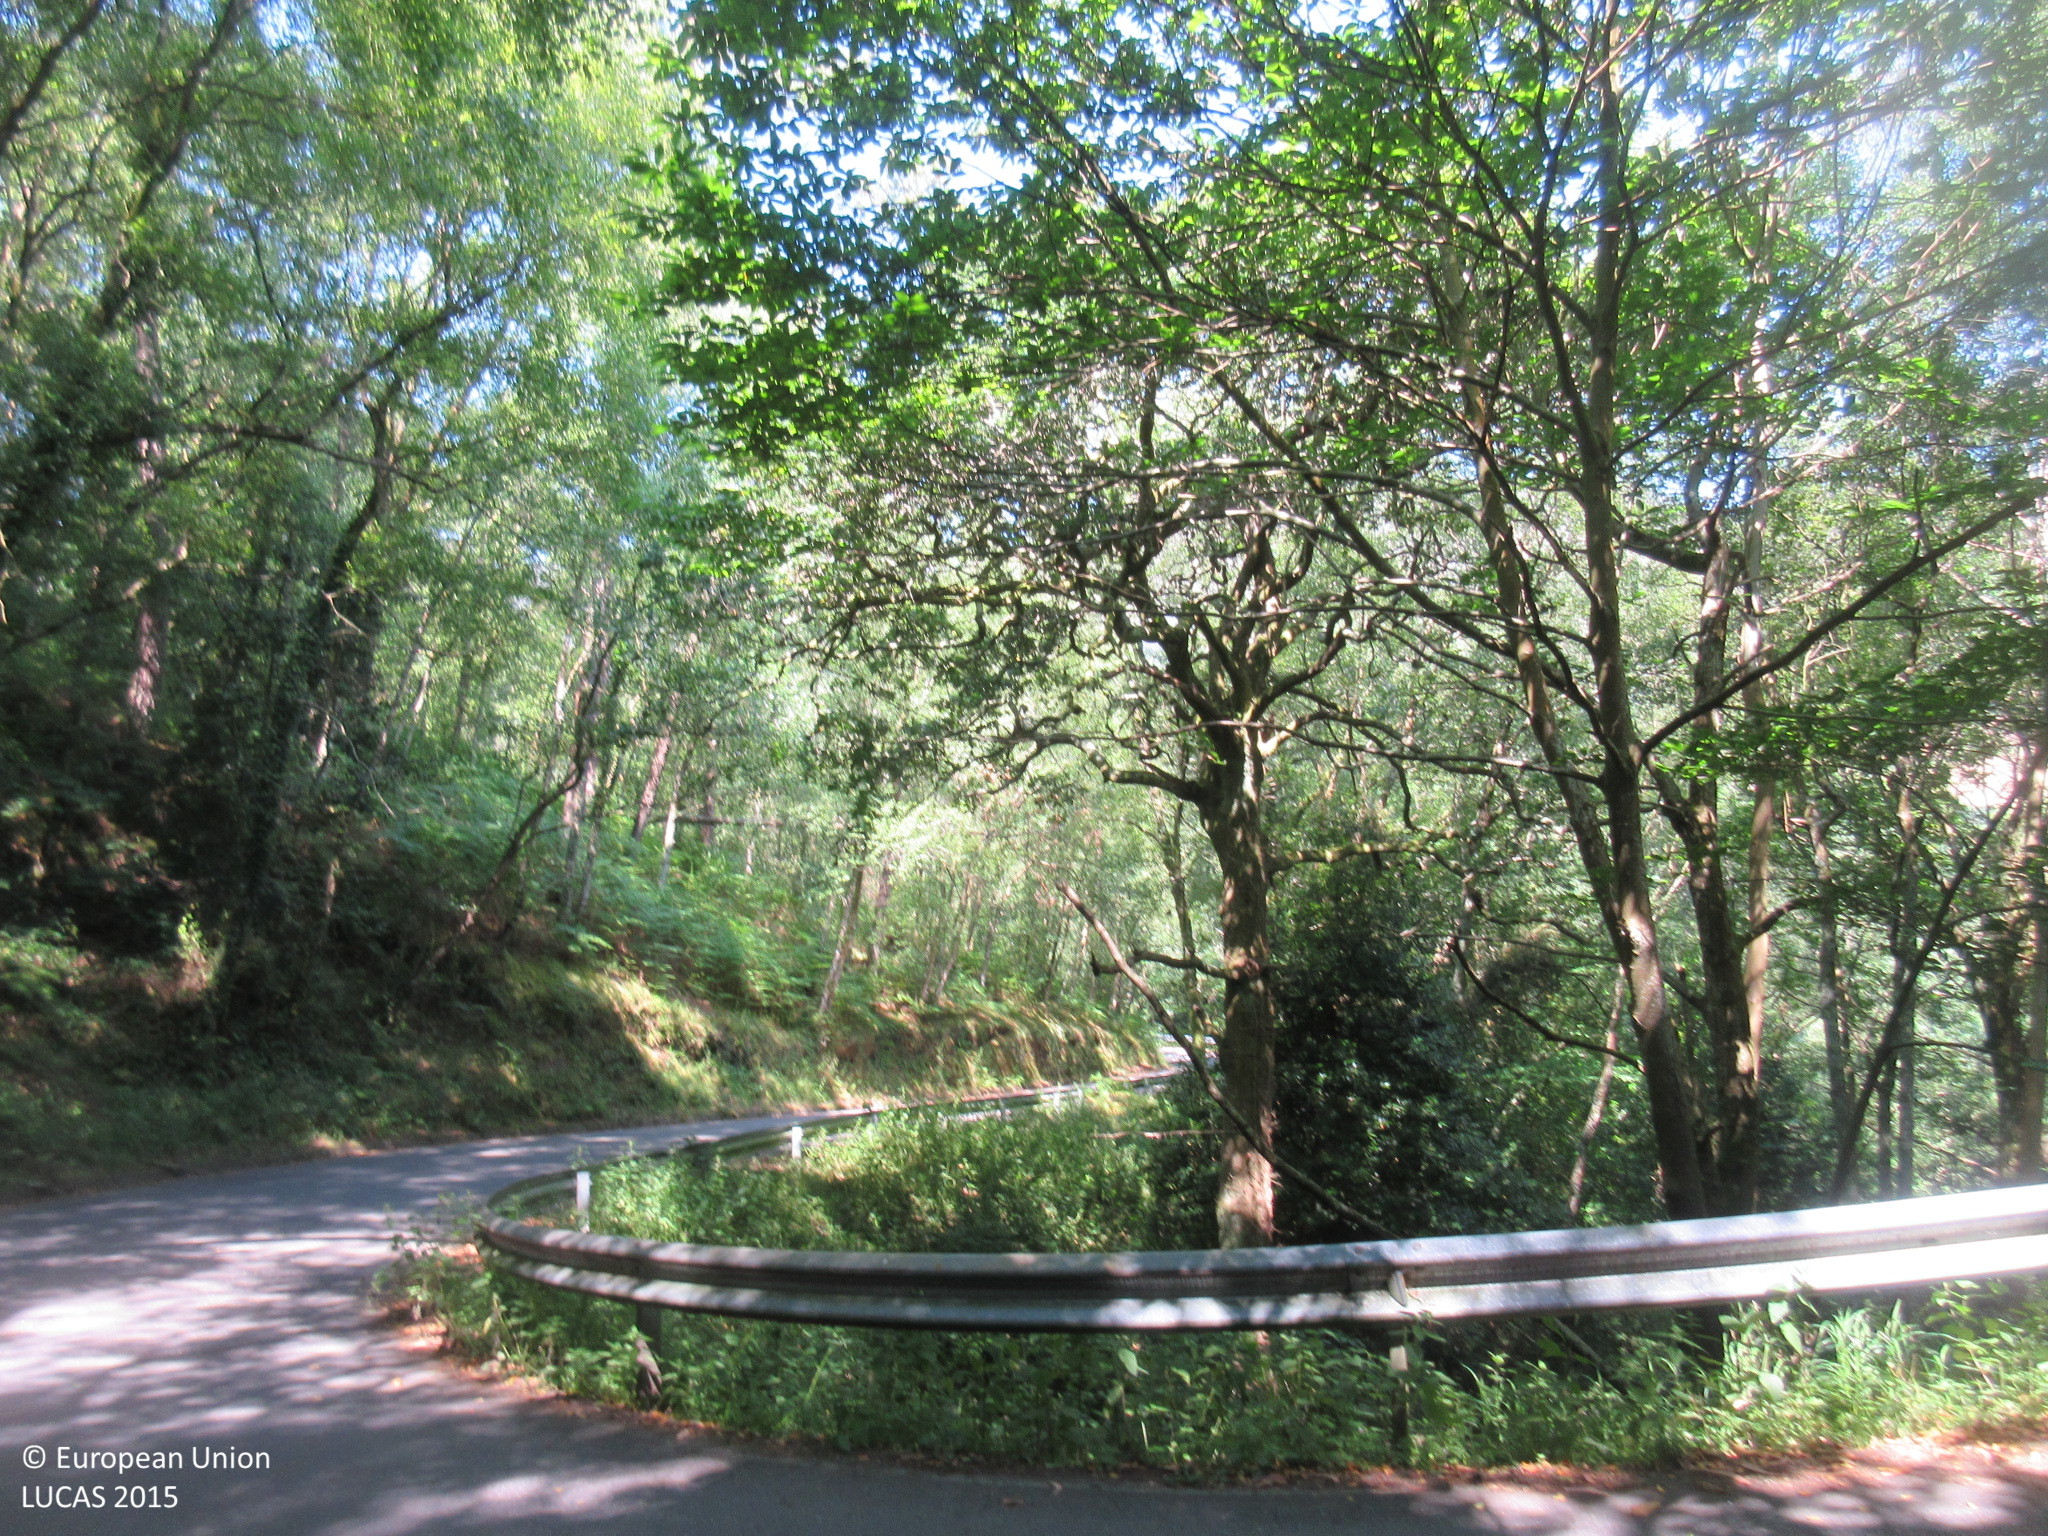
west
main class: Woodland
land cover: Broadleaved woodland
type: thermophilous deciduous forest
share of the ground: > 75 %
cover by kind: broadleaved forest trees 100 %
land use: Forestry
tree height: > 5 m
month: July
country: ES
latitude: 43.4782
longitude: -6.6118
